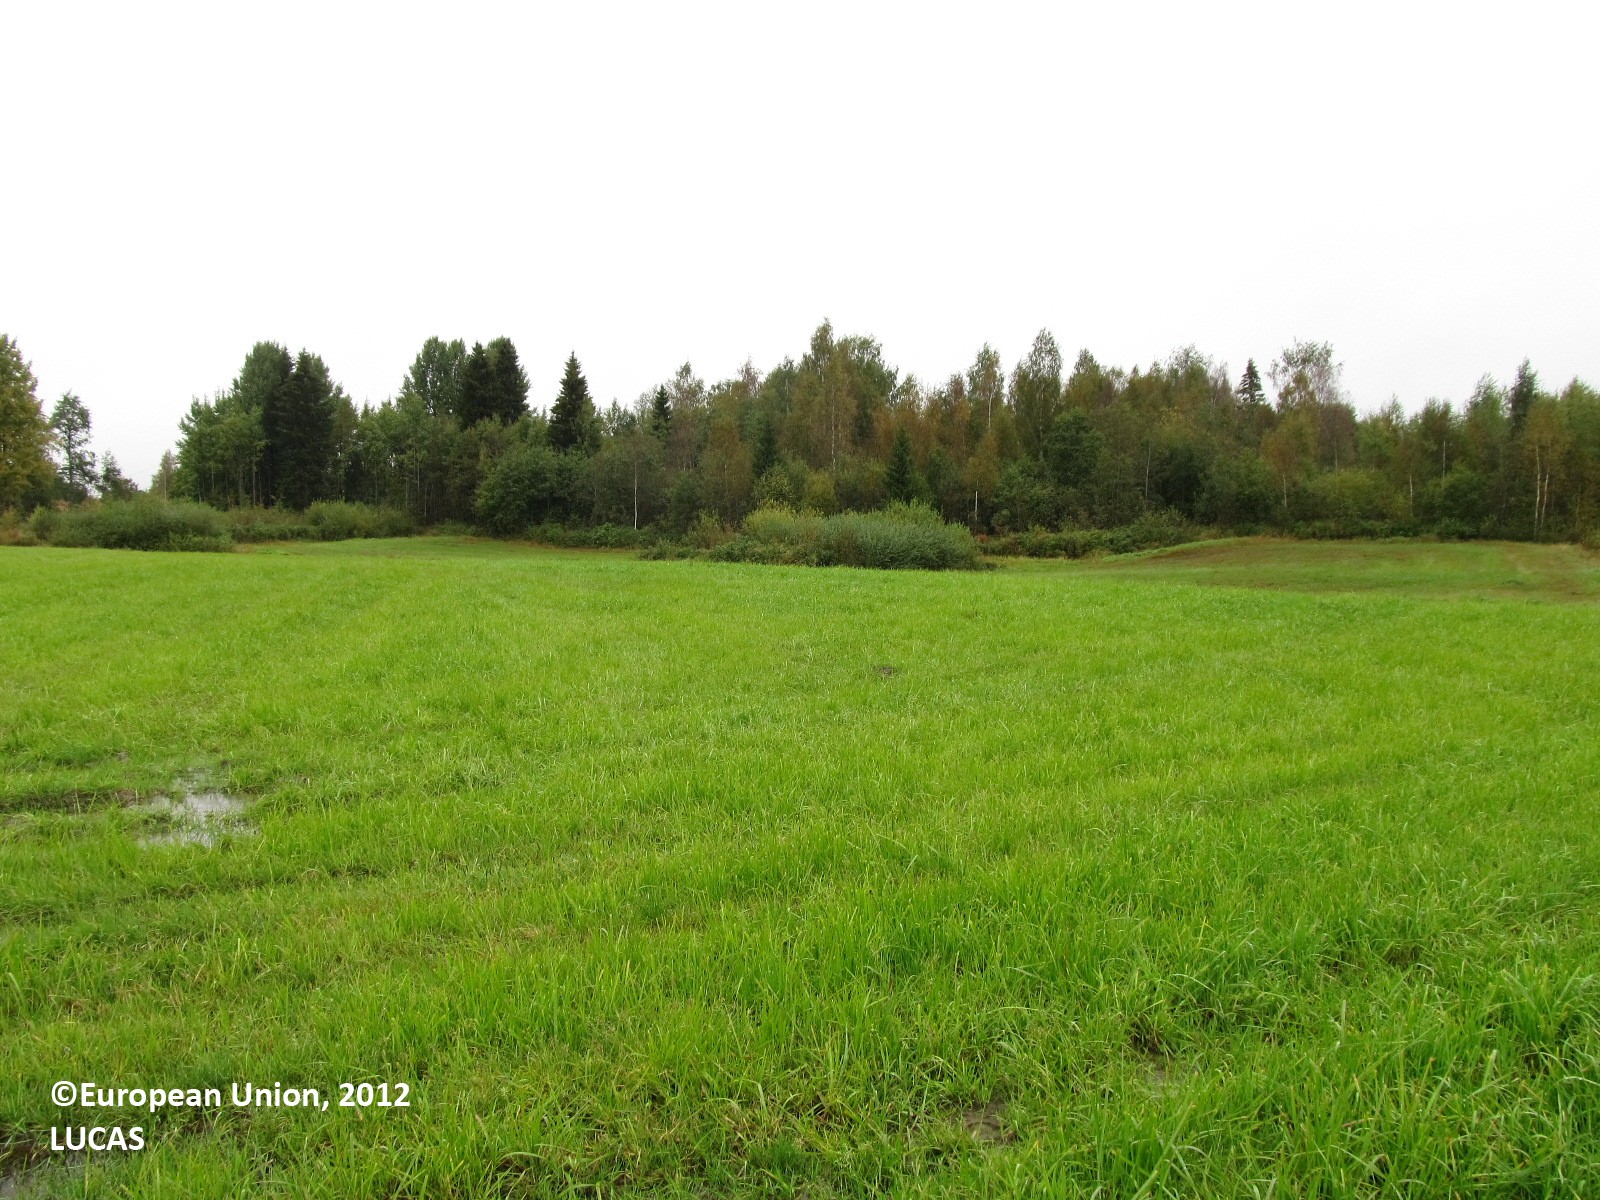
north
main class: Cropland
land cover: Temporary grasslands
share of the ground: > 75 %
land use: Agriculture (excluding fallow land and kitchen gardens)
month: September
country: FI
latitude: 63.1477
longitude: 28.0165
